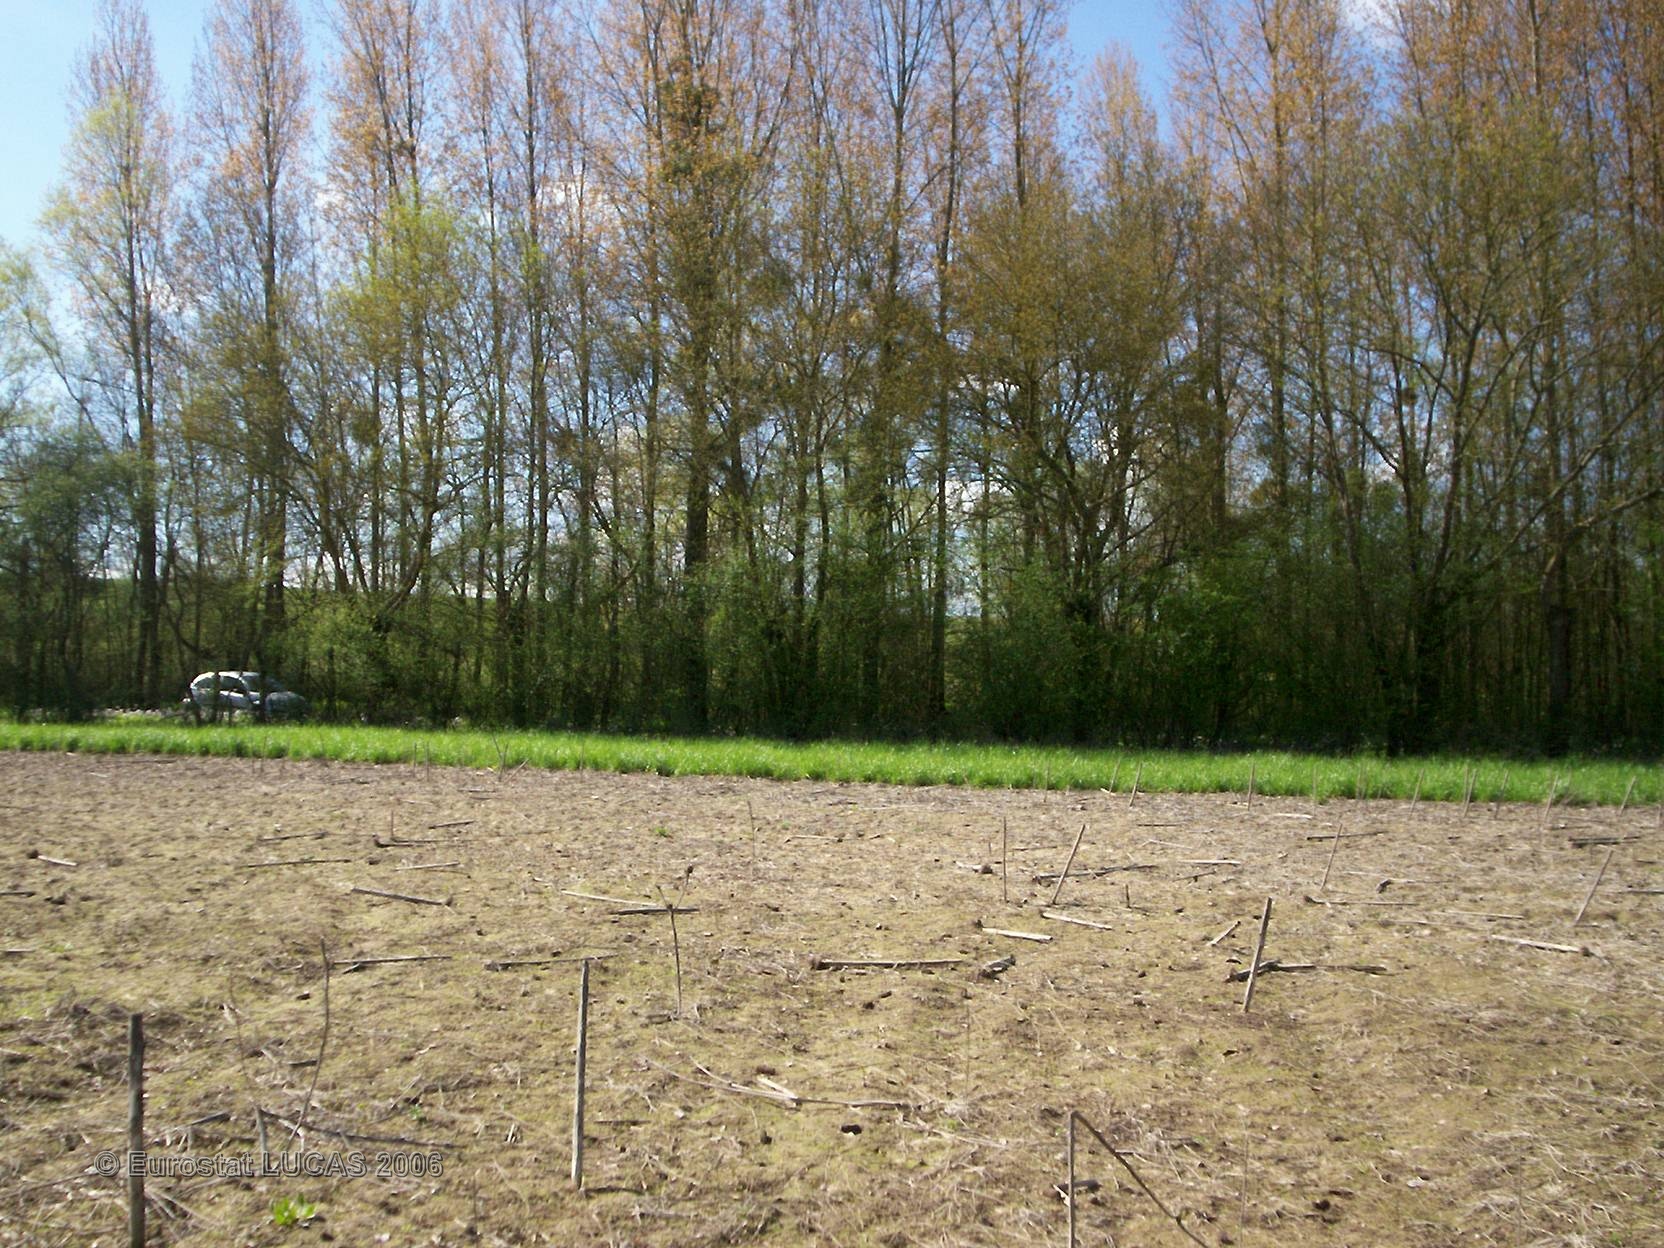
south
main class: Cropland
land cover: Maize
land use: Agriculture (excluding fallow land and kitchen gardens)
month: May
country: FR
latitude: 47.5634
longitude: -0.4376
